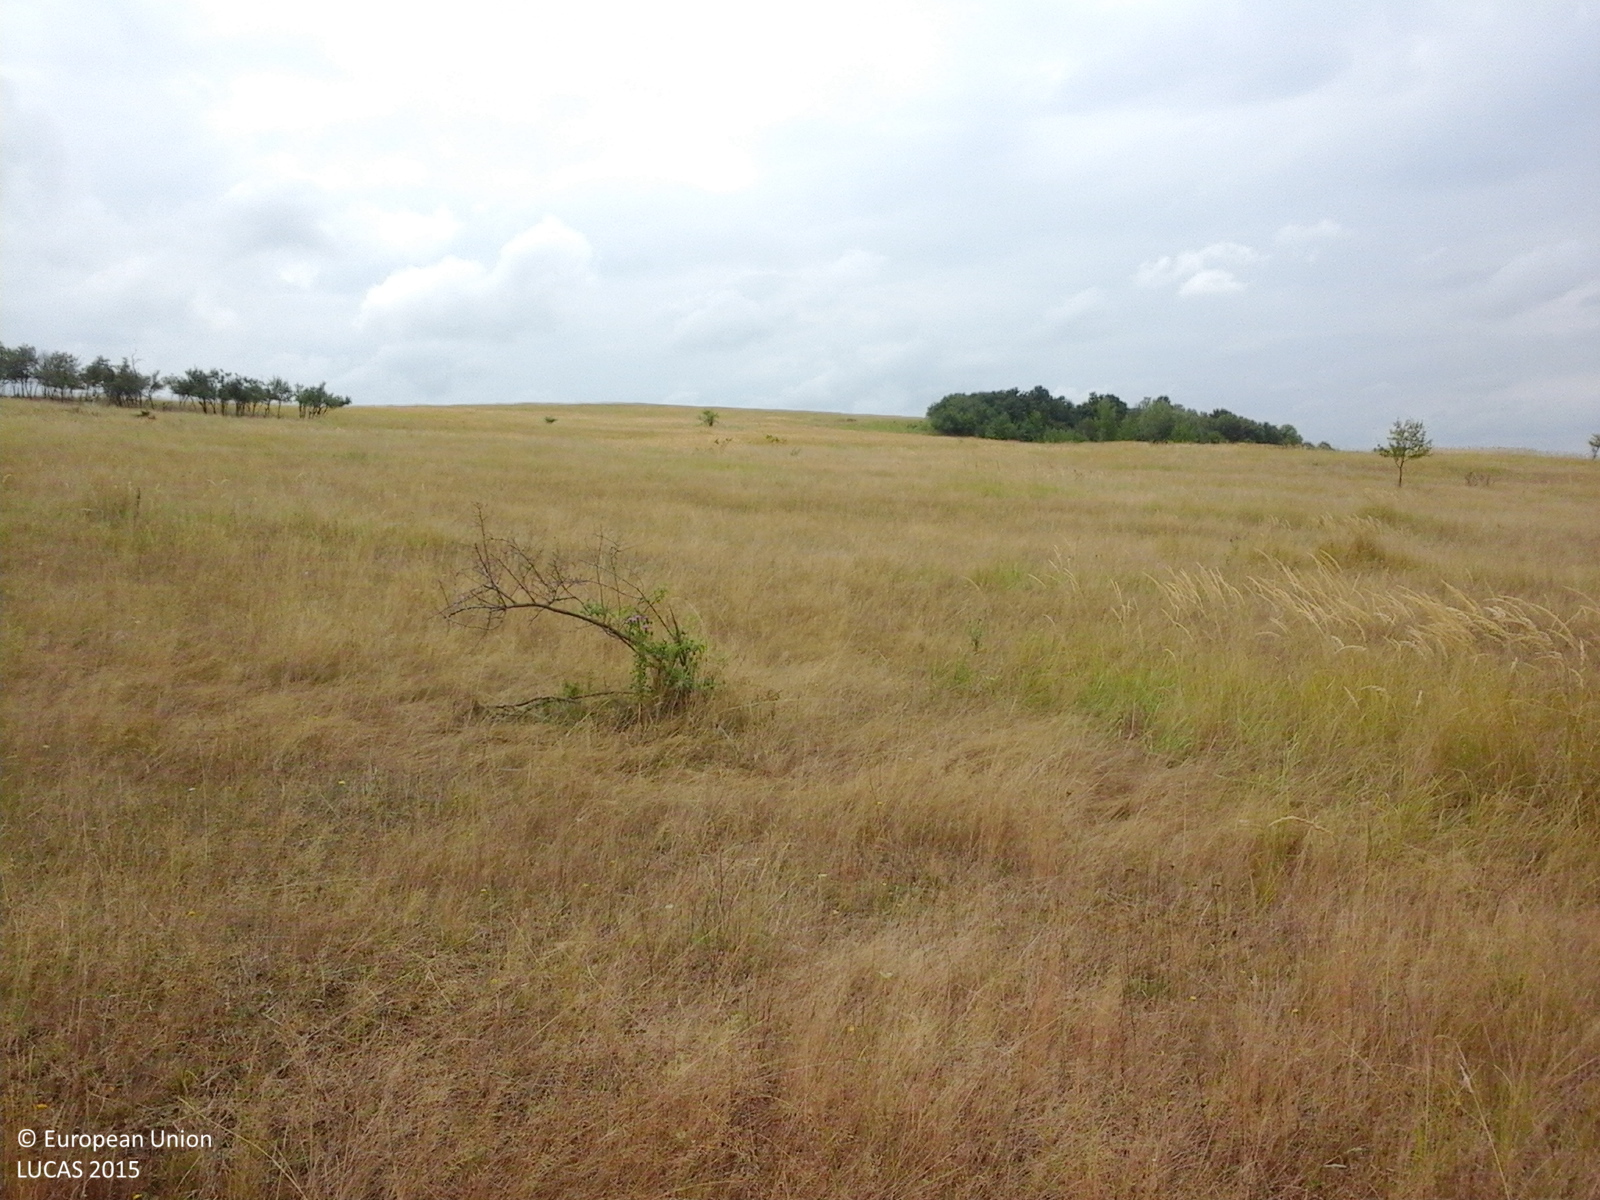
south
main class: Grassland
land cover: Grassland without tree/shrub cover
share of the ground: > 75 %
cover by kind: herbaceous plants 100 %
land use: Agriculture (excluding fallow land and kitchen gardens)
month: August
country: RO
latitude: 45.8567
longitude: 21.8228
